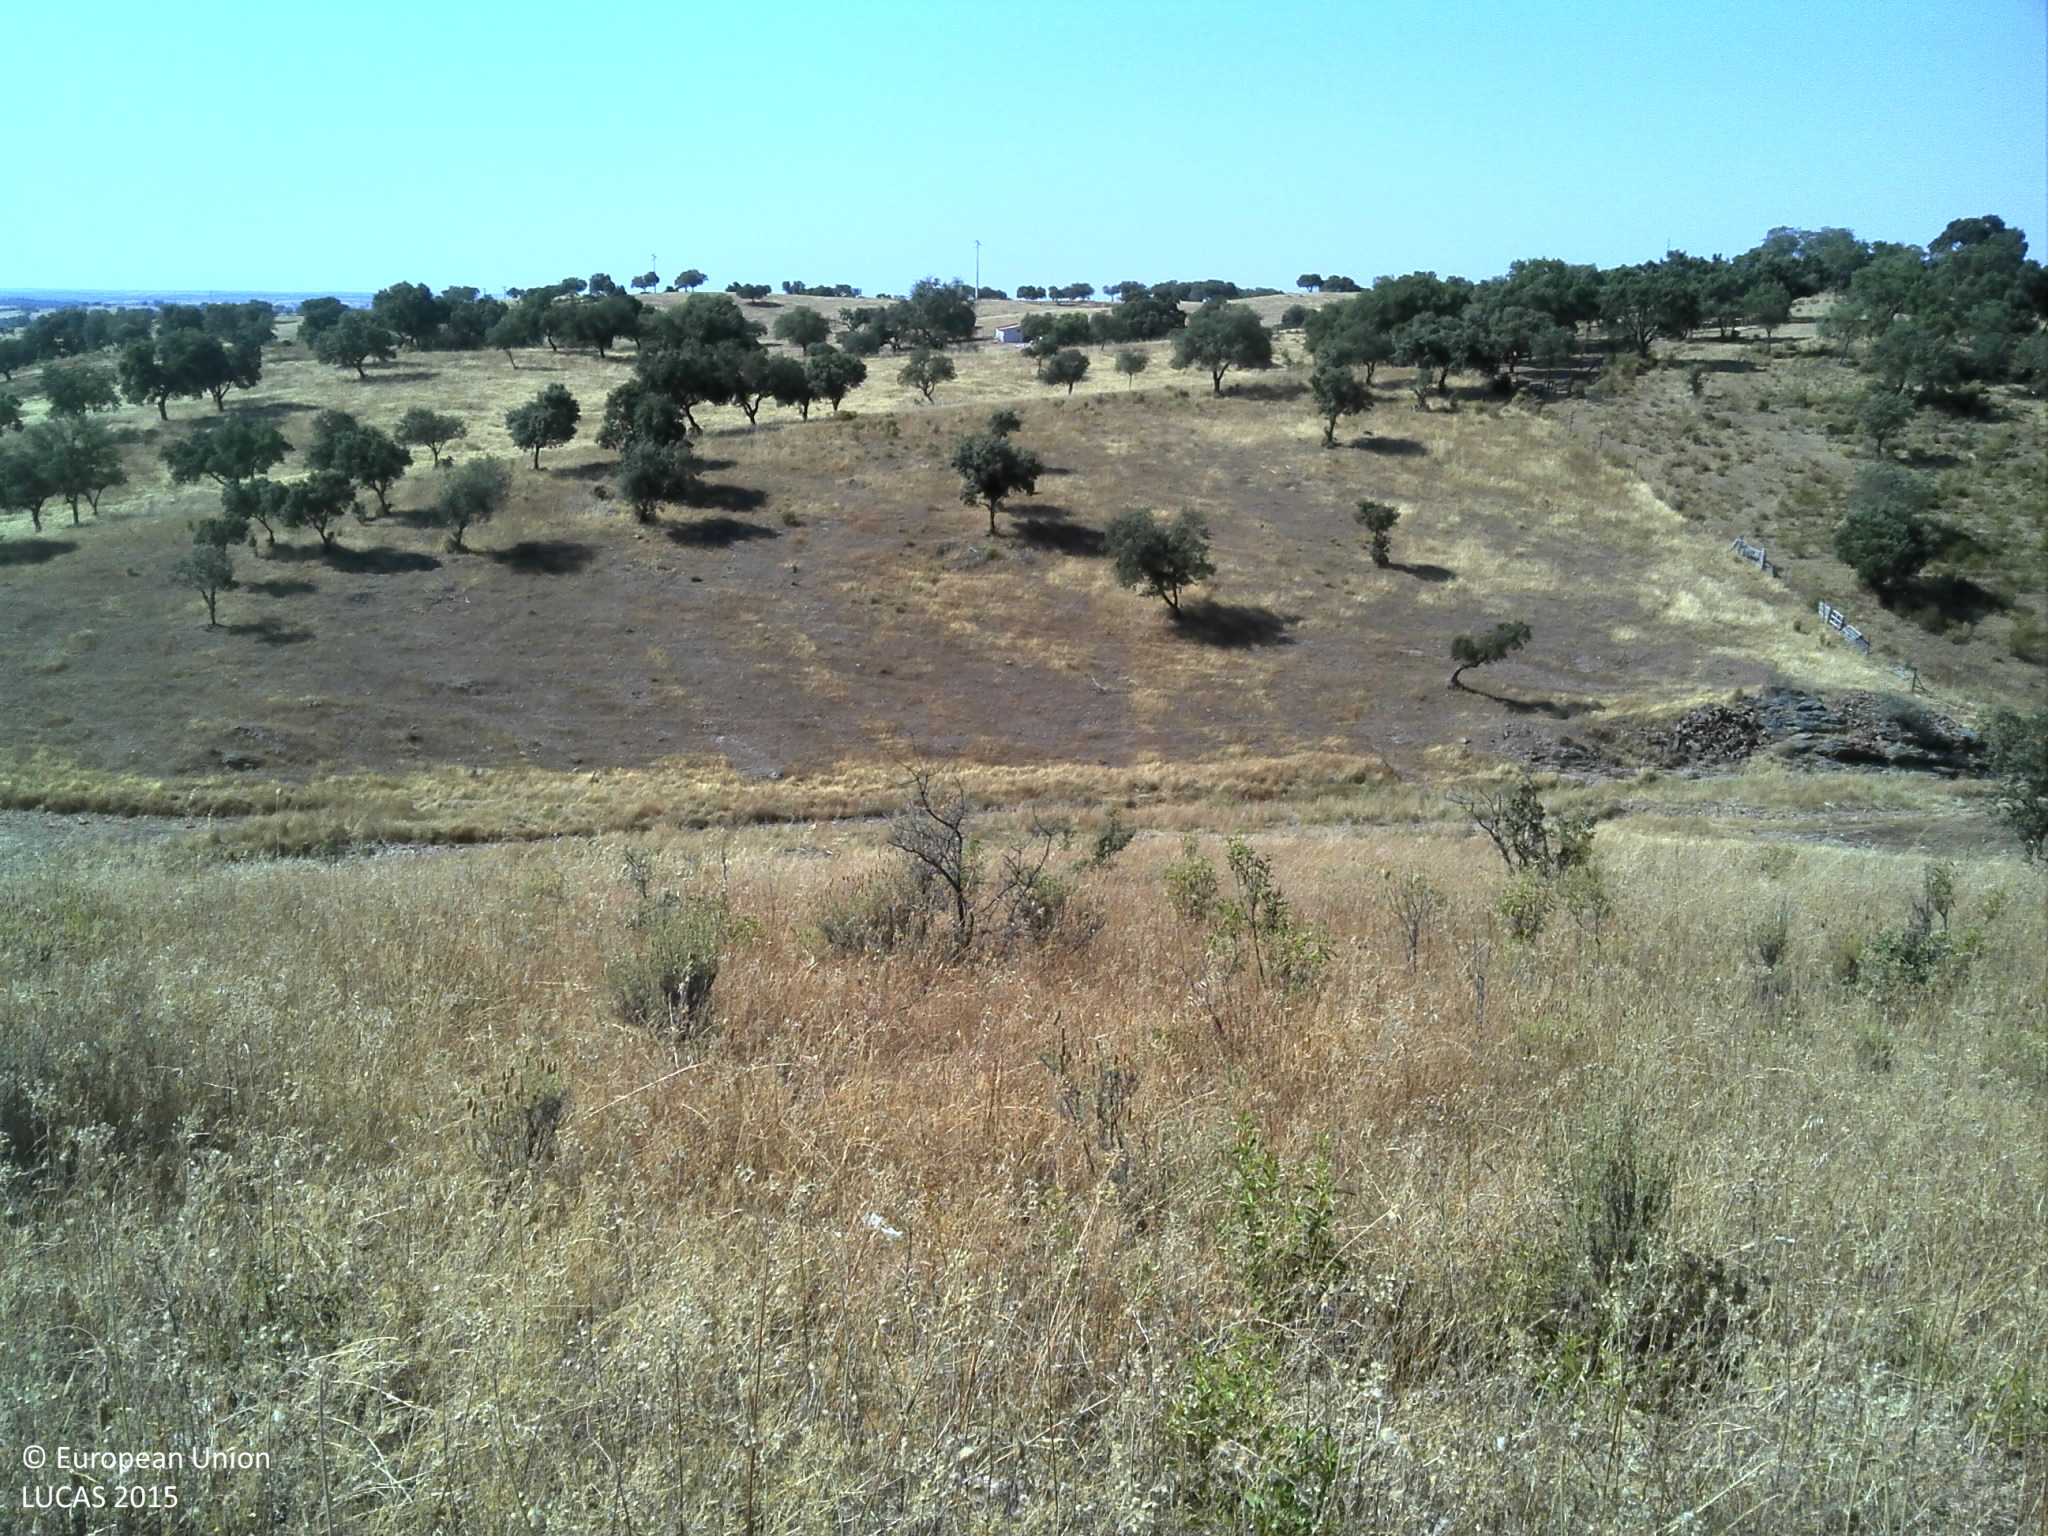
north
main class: Grassland
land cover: Grassland with sparse tree/shrub cover
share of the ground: > 75 %
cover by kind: herbaceous plants 75 %, unconsolidated bare surface 20 %, broadleaved forest trees 5 %
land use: Agriculture (excluding fallow land and kitchen gardens)
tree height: < 5 m
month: June
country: PT
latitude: 38.0072
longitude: -7.2454
